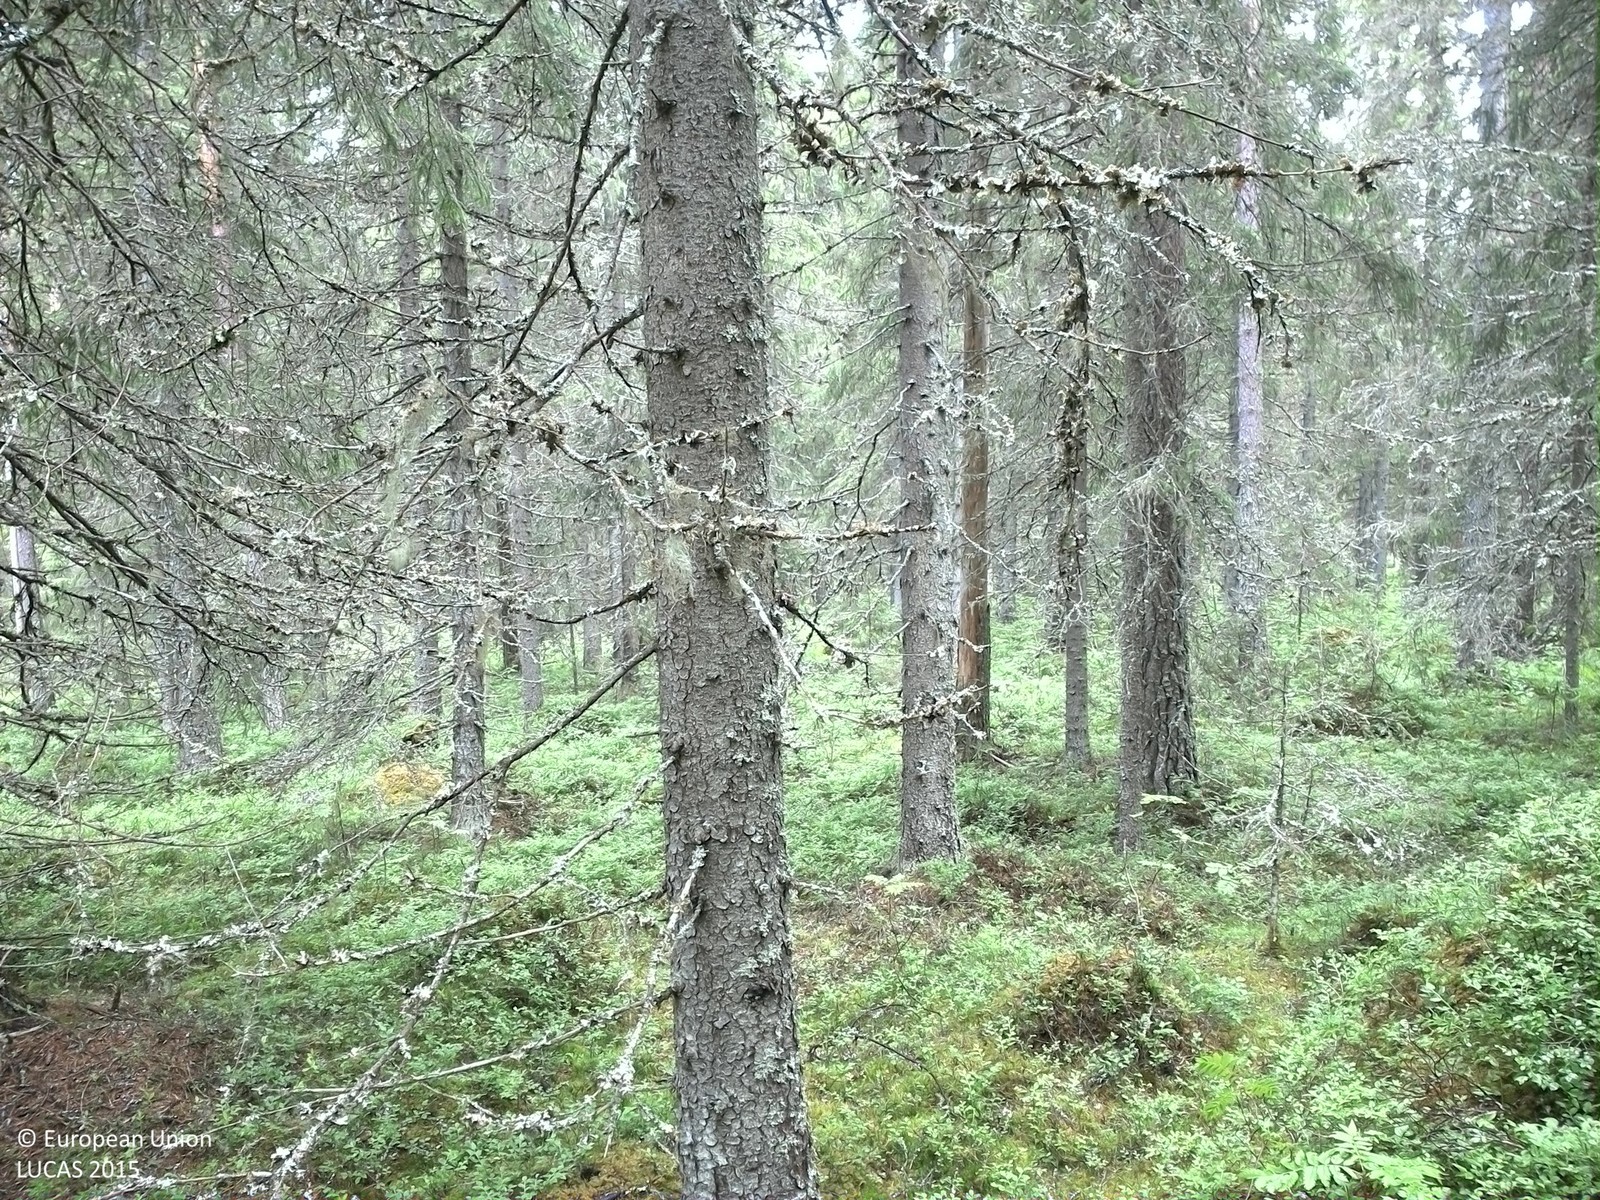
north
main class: Woodland
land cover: Spruce dominated coniferous woodland
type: boreal forest
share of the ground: 50 - 75 %
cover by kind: coniferous forest trees 60 %, shrubs 30 %, broadleaved forest trees 5 %, lichens and mosses 5 %
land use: Forestry
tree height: > 5 m
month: July
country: SE
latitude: 63.5619
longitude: 18.6527
